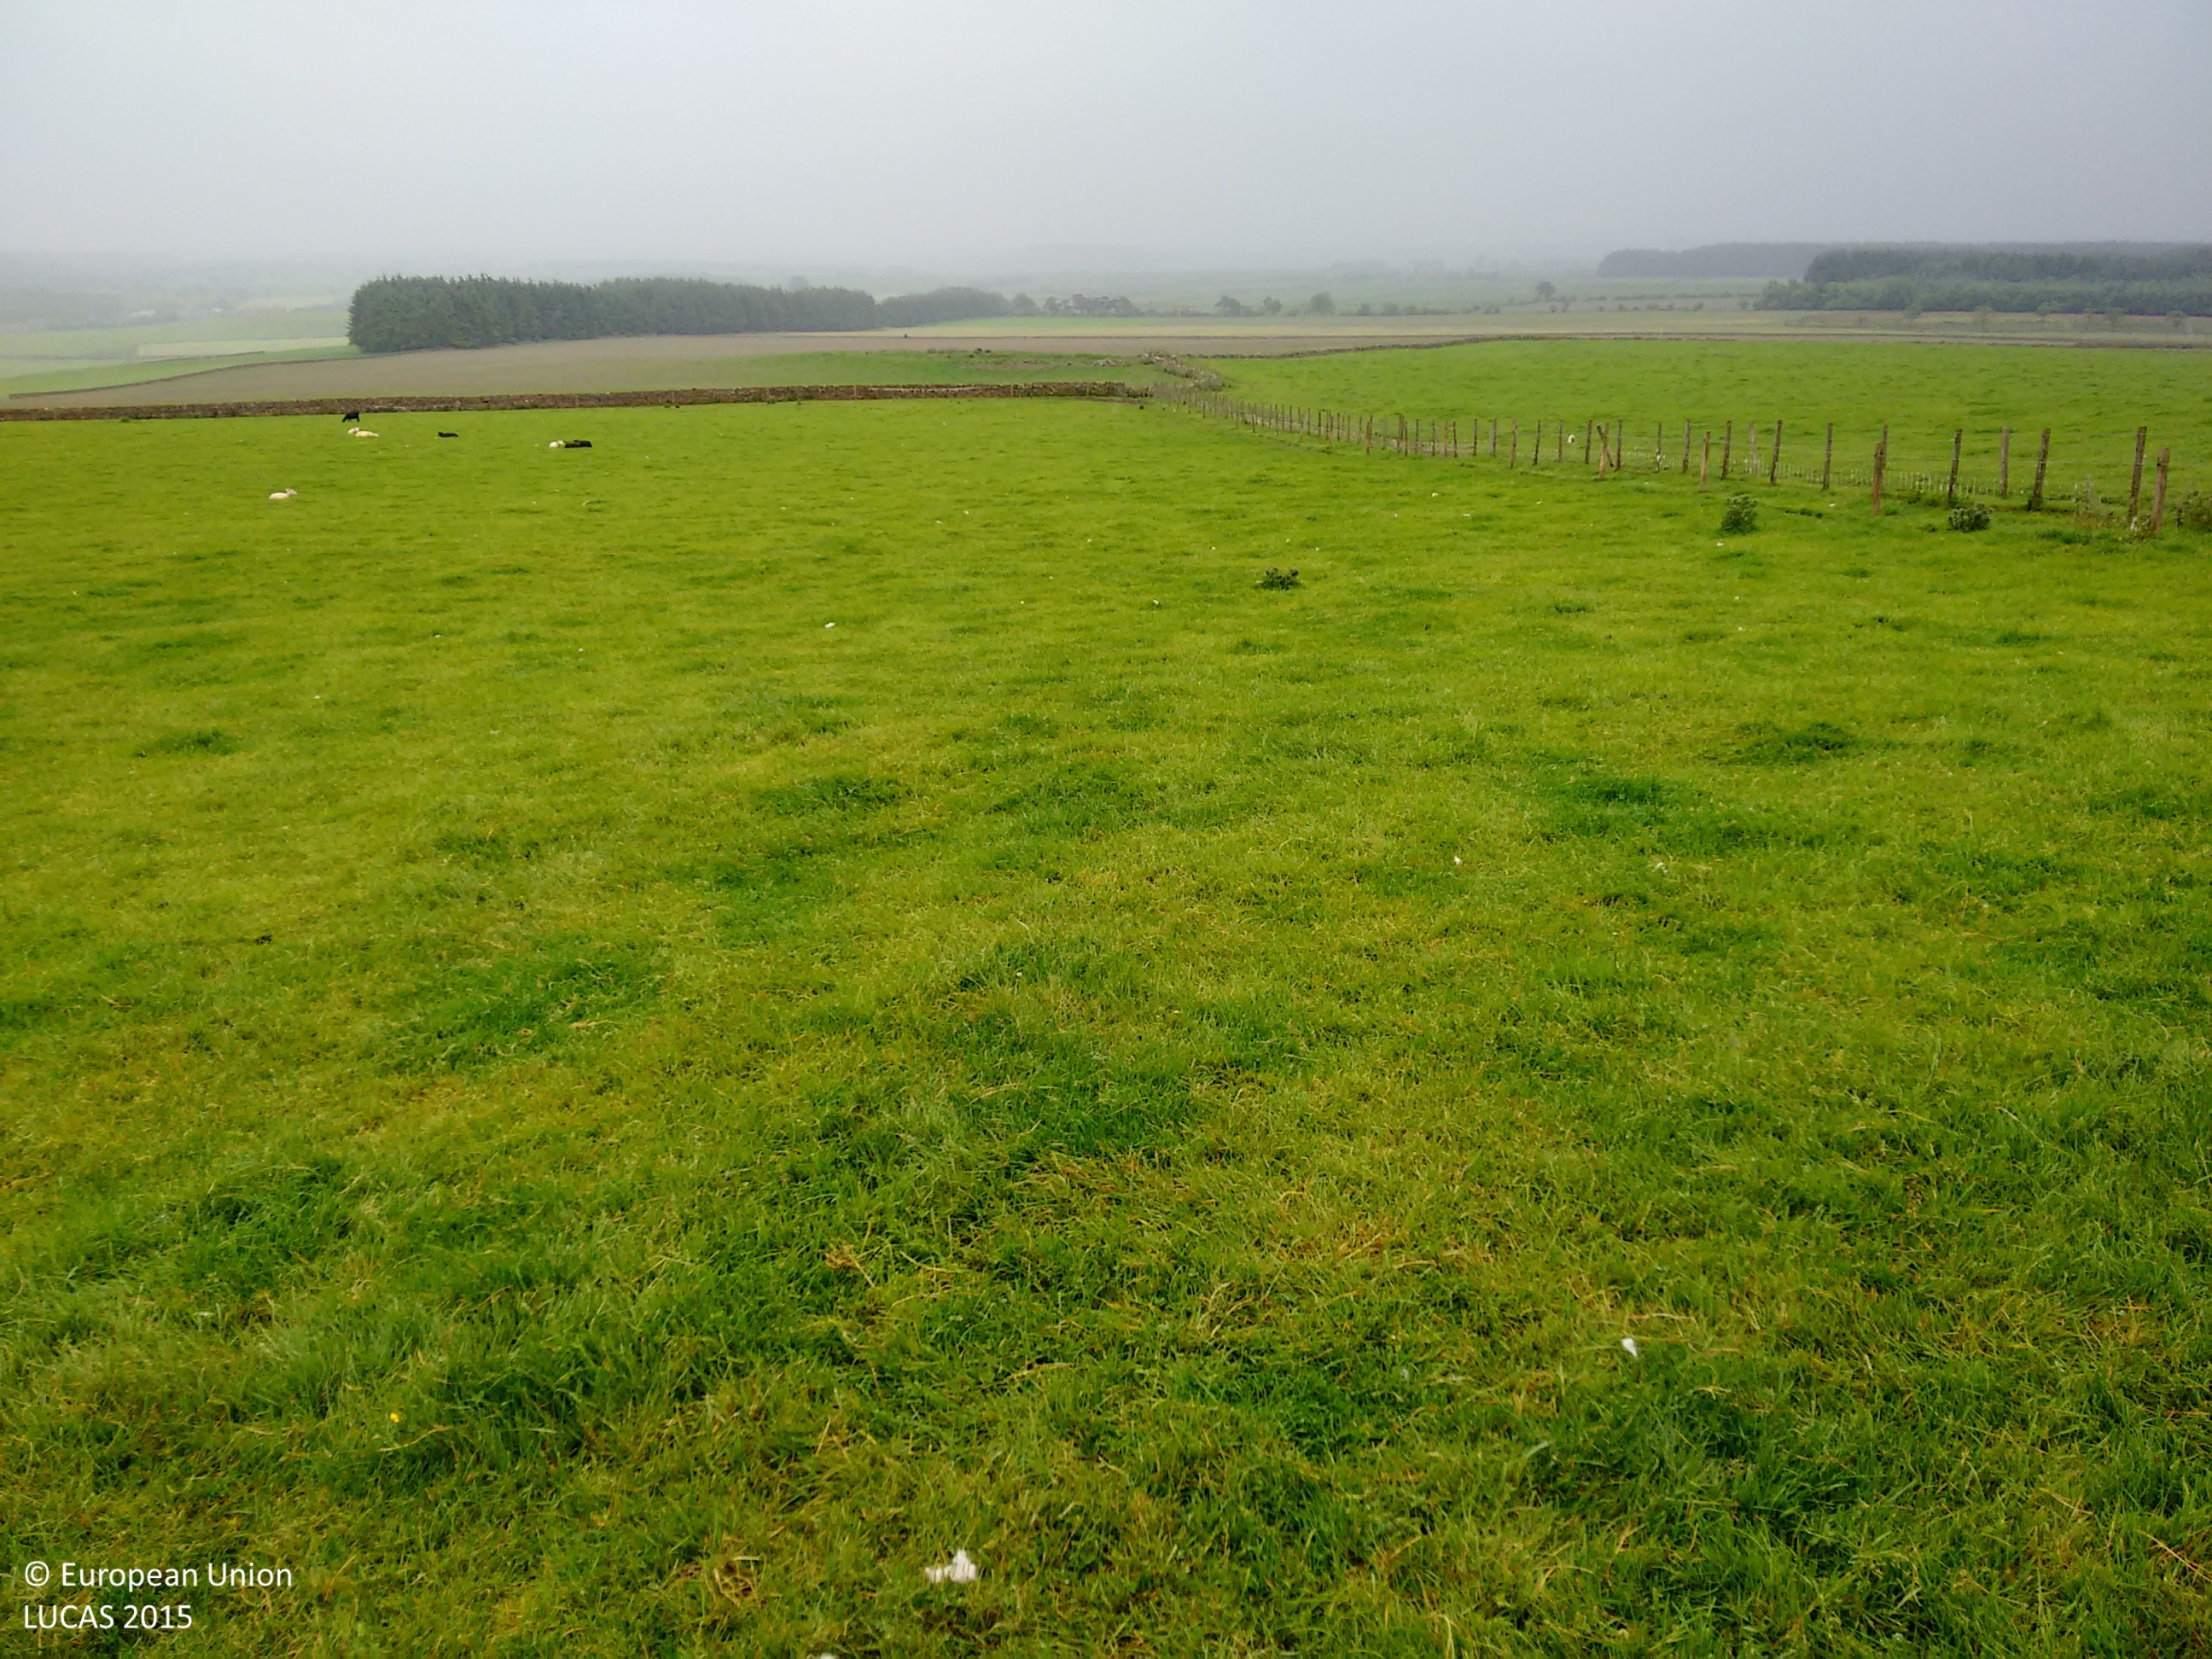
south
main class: Grassland
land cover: Grassland without tree/shrub cover
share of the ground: > 75 %
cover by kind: herbaceous plants 100 %
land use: Agriculture (excluding fallow land and kitchen gardens)
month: June
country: GB
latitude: 55.0353
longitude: -3.2981
